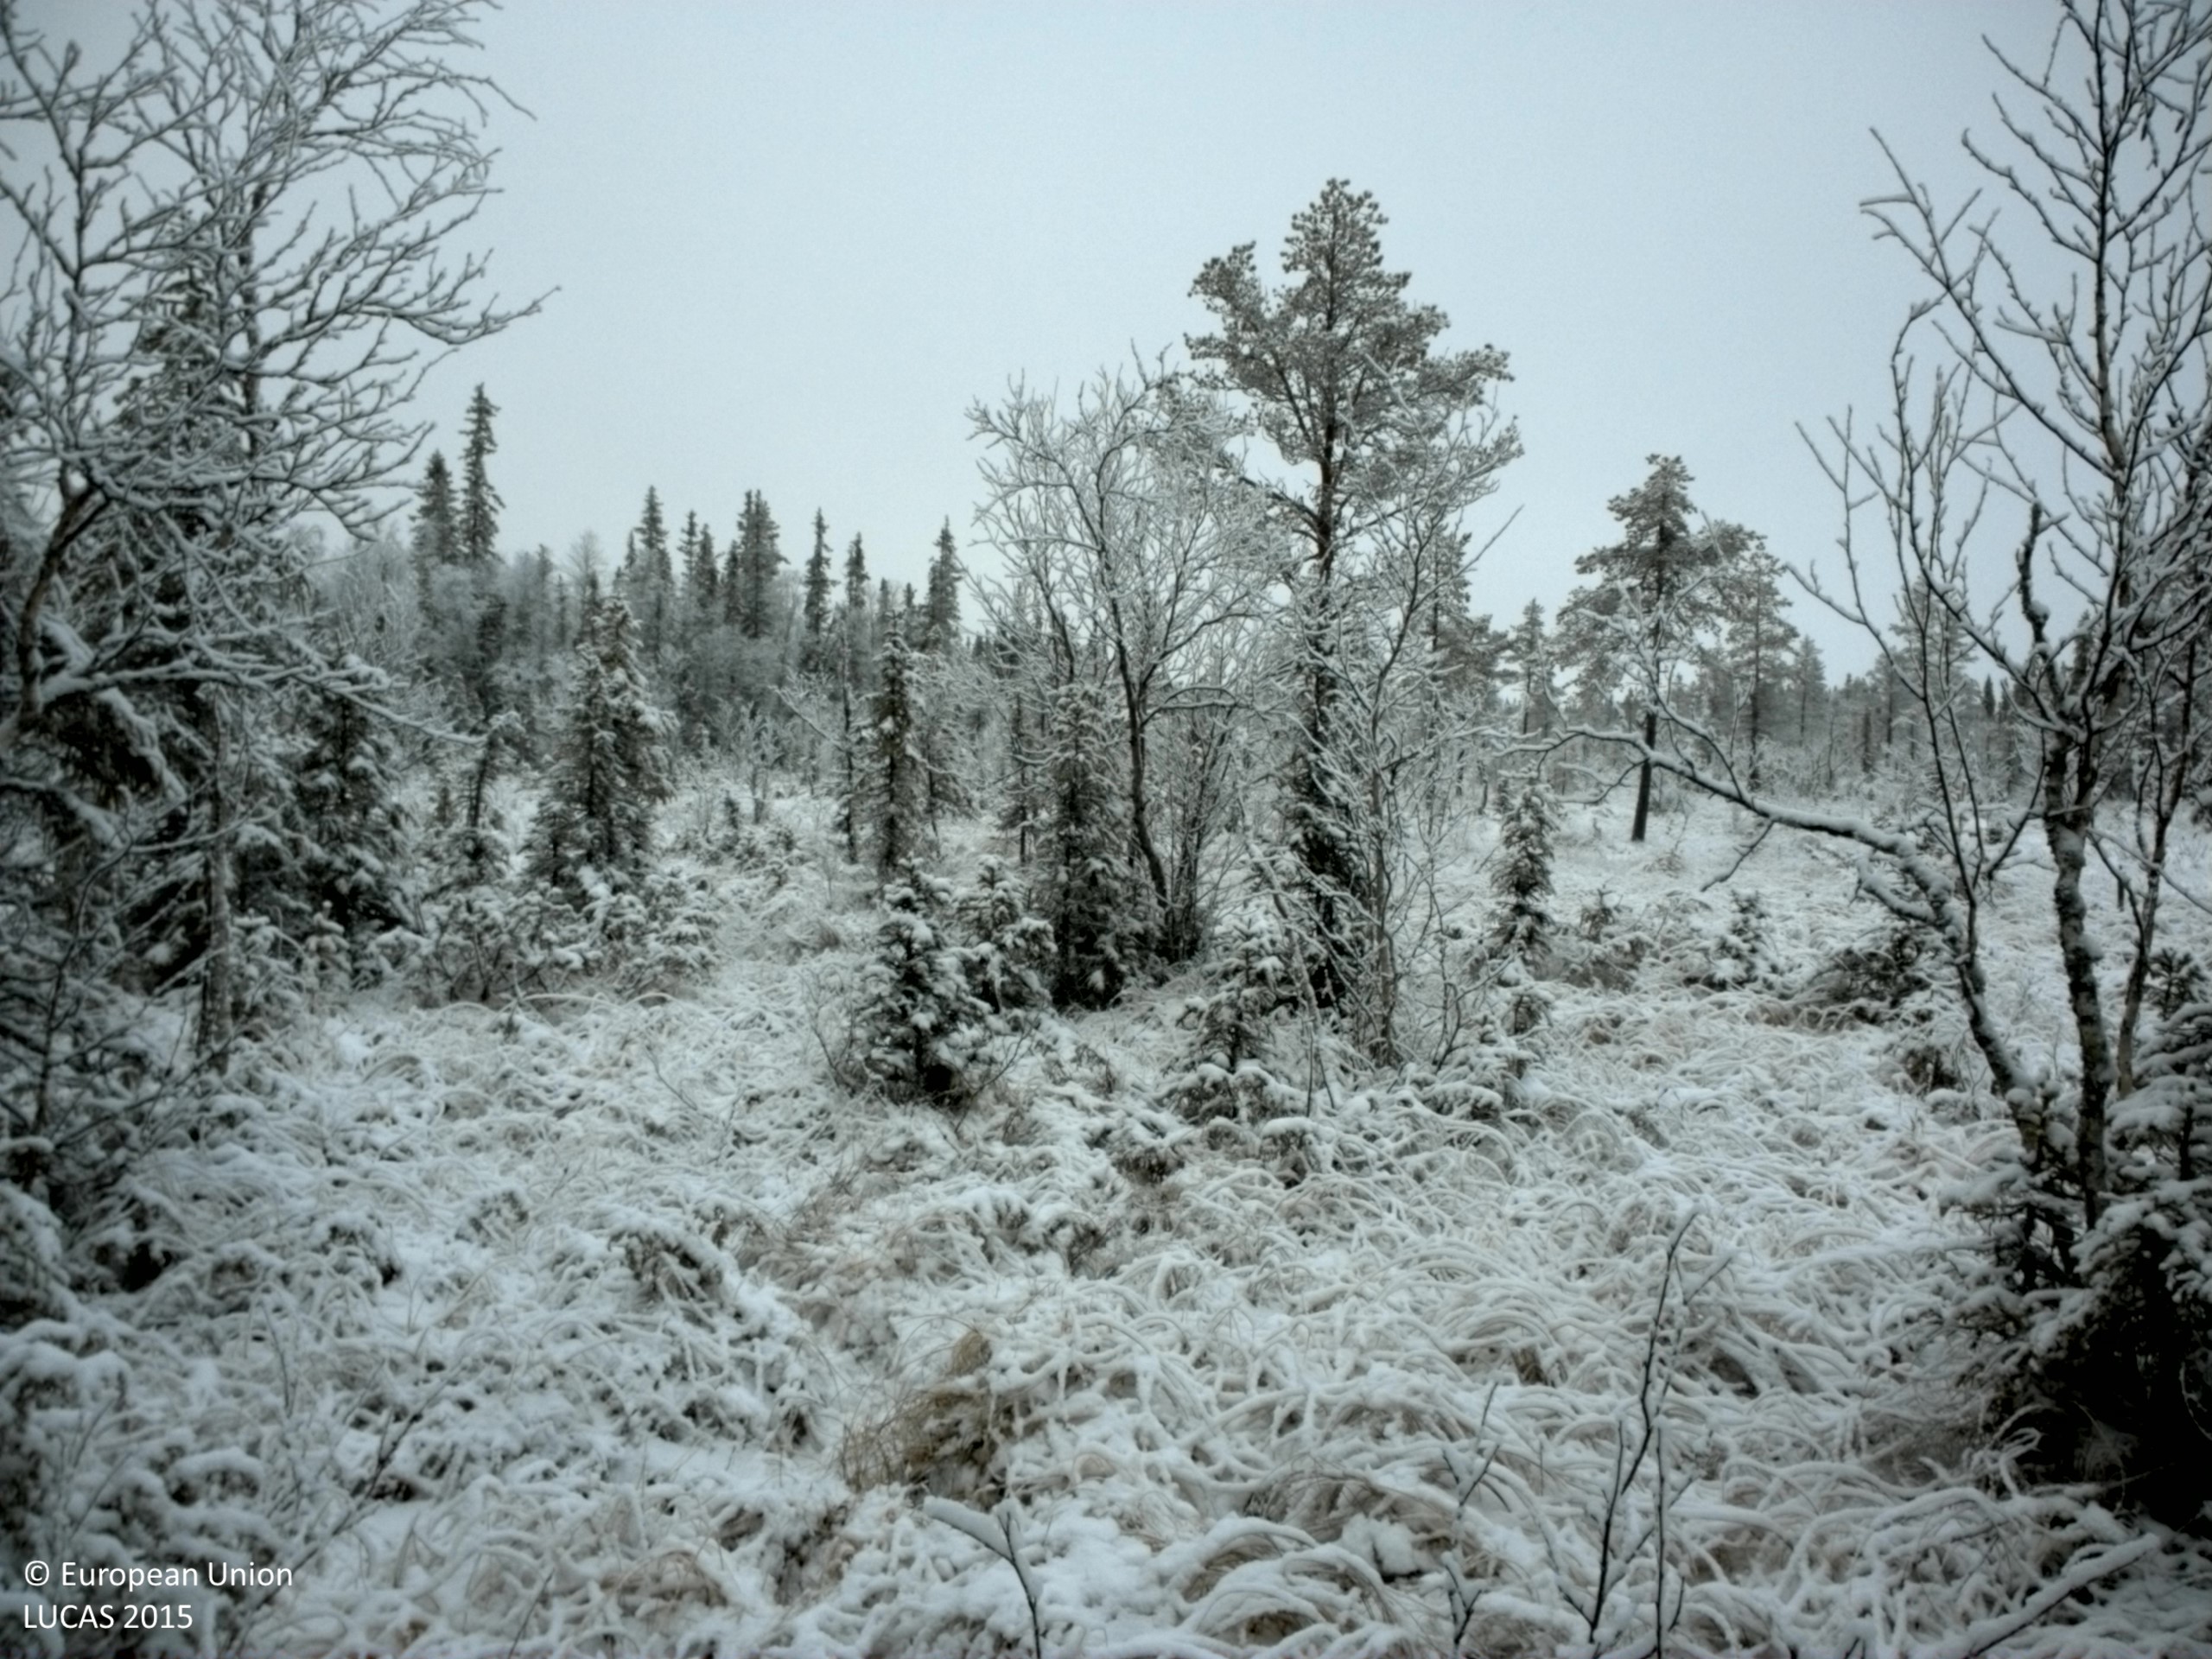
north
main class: Woodland
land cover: Spruce dominated mixed woodland
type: mire and swamp forests
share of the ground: 25 - 50 %
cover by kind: herbaceous plants 40 %, lichens and mosses 20 %, coniferous forest trees 15 %, shrubs 15 %, broadleaved forest trees 10 %
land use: Forestry
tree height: < 5 m
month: November
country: SE
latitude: 63.7319
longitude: 15.2604
